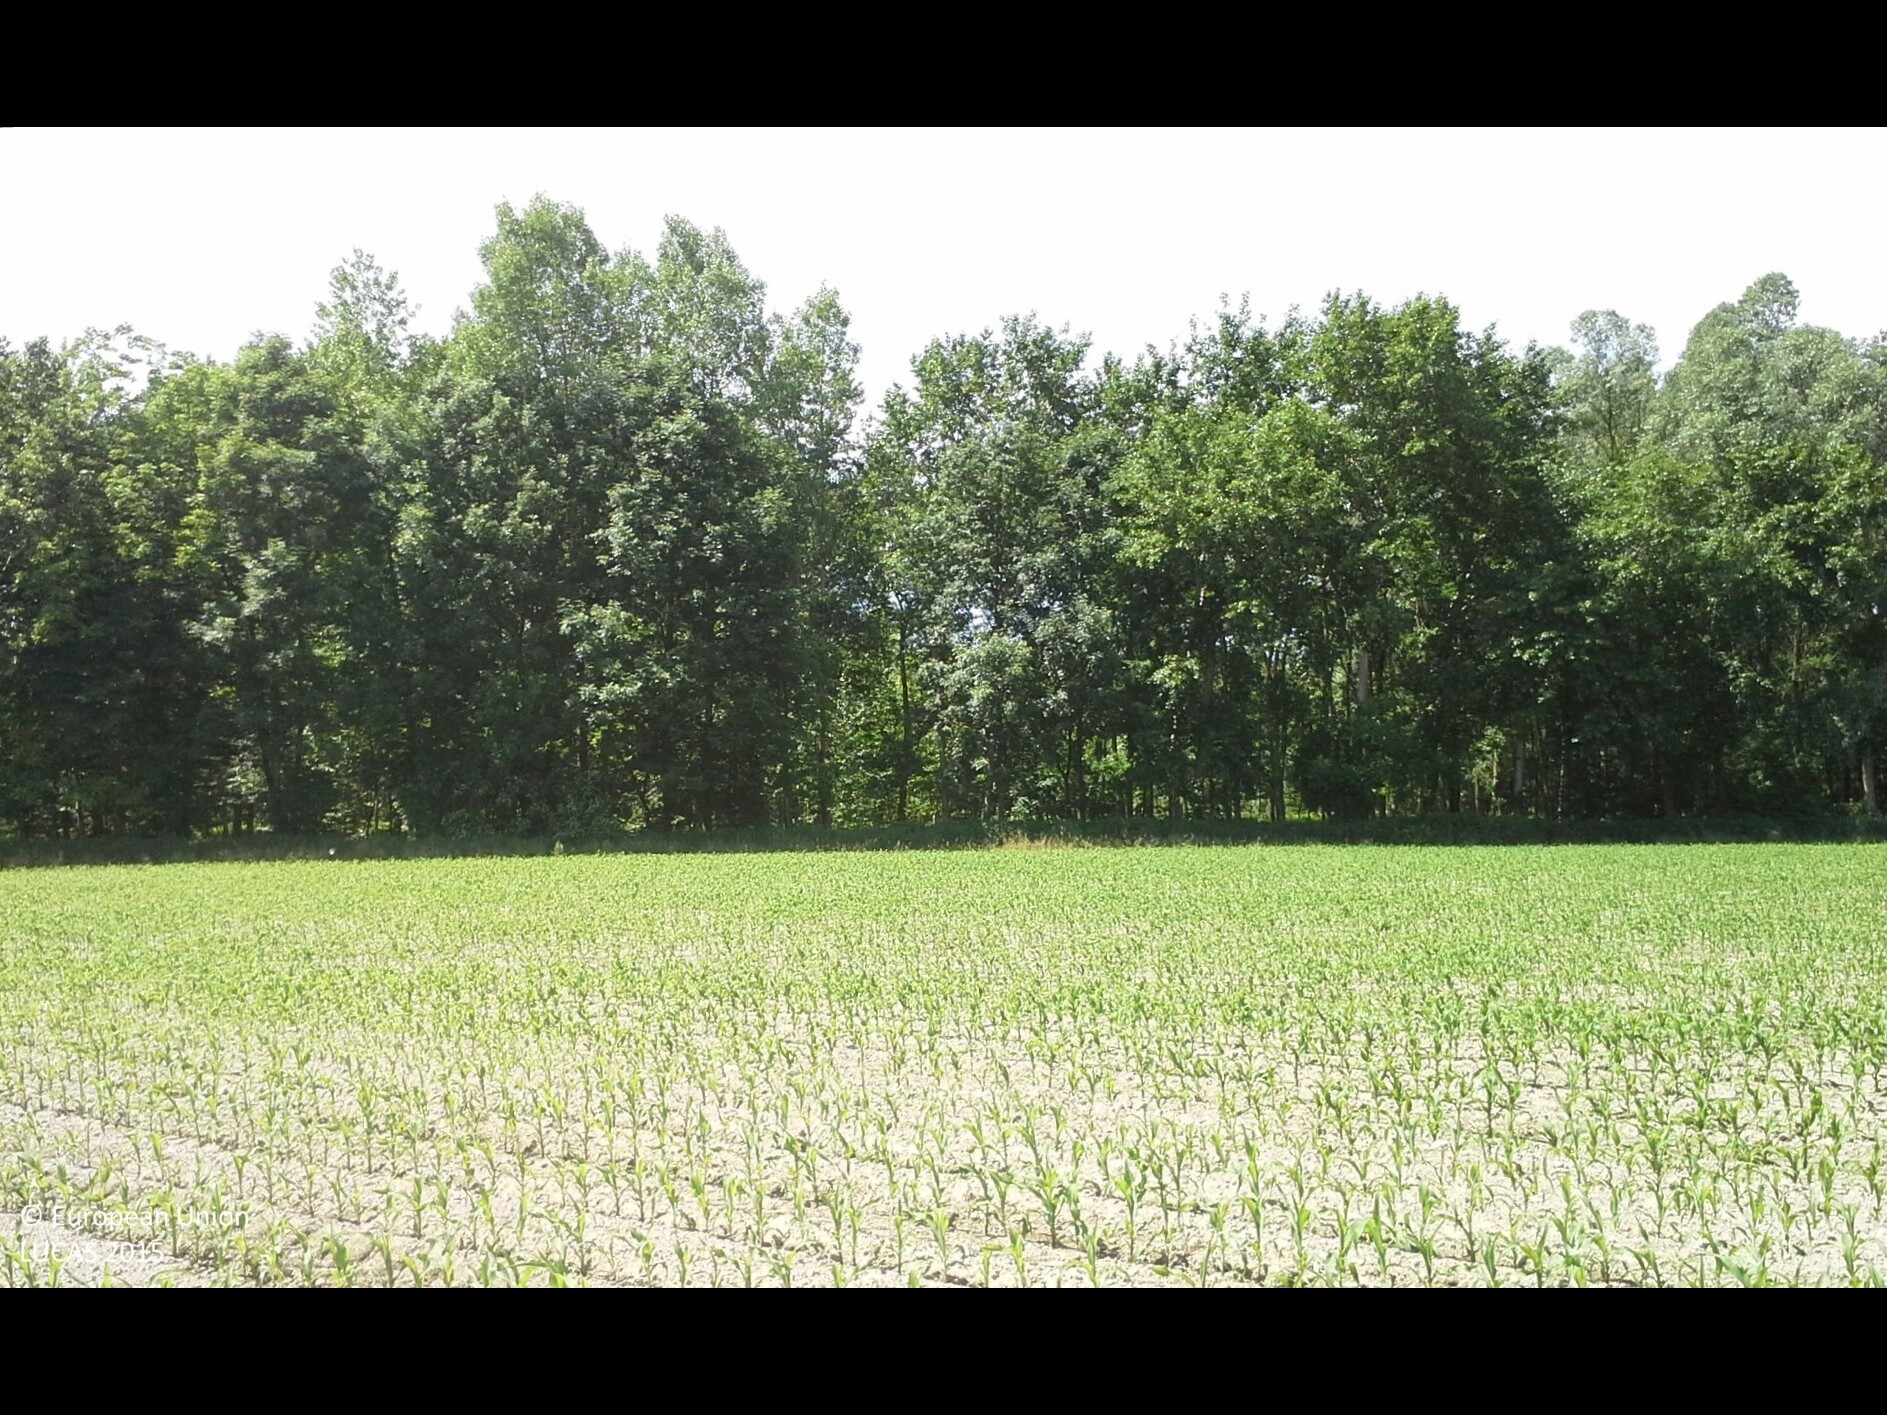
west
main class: Cropland
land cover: Maize
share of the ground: 25 - 50 %
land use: Agriculture (excluding fallow land and kitchen gardens)
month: June
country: AT
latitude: 48.1742
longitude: 14.7747
